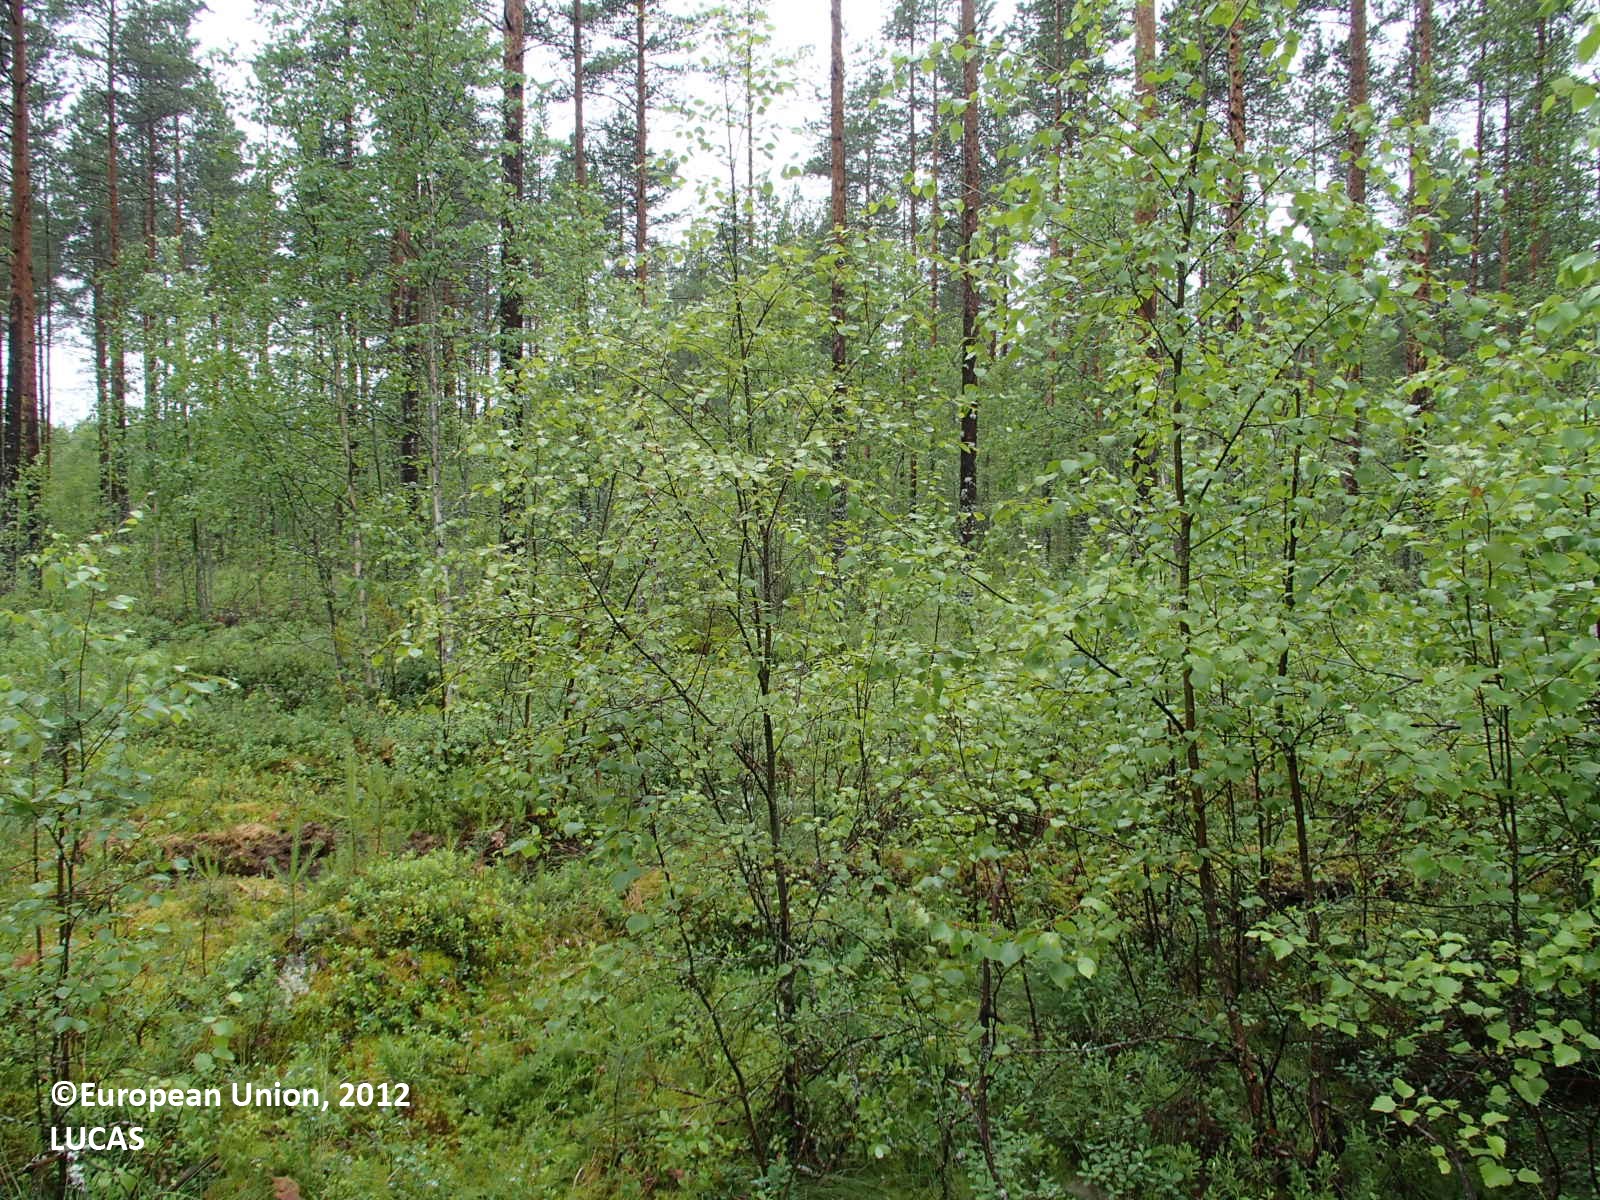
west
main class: Woodland
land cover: Pine dominated mixed woodland
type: boreal forest
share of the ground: > 75 %
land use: Forestry
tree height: > 5 m
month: July
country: FI
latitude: 64.3939
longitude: 26.3499
